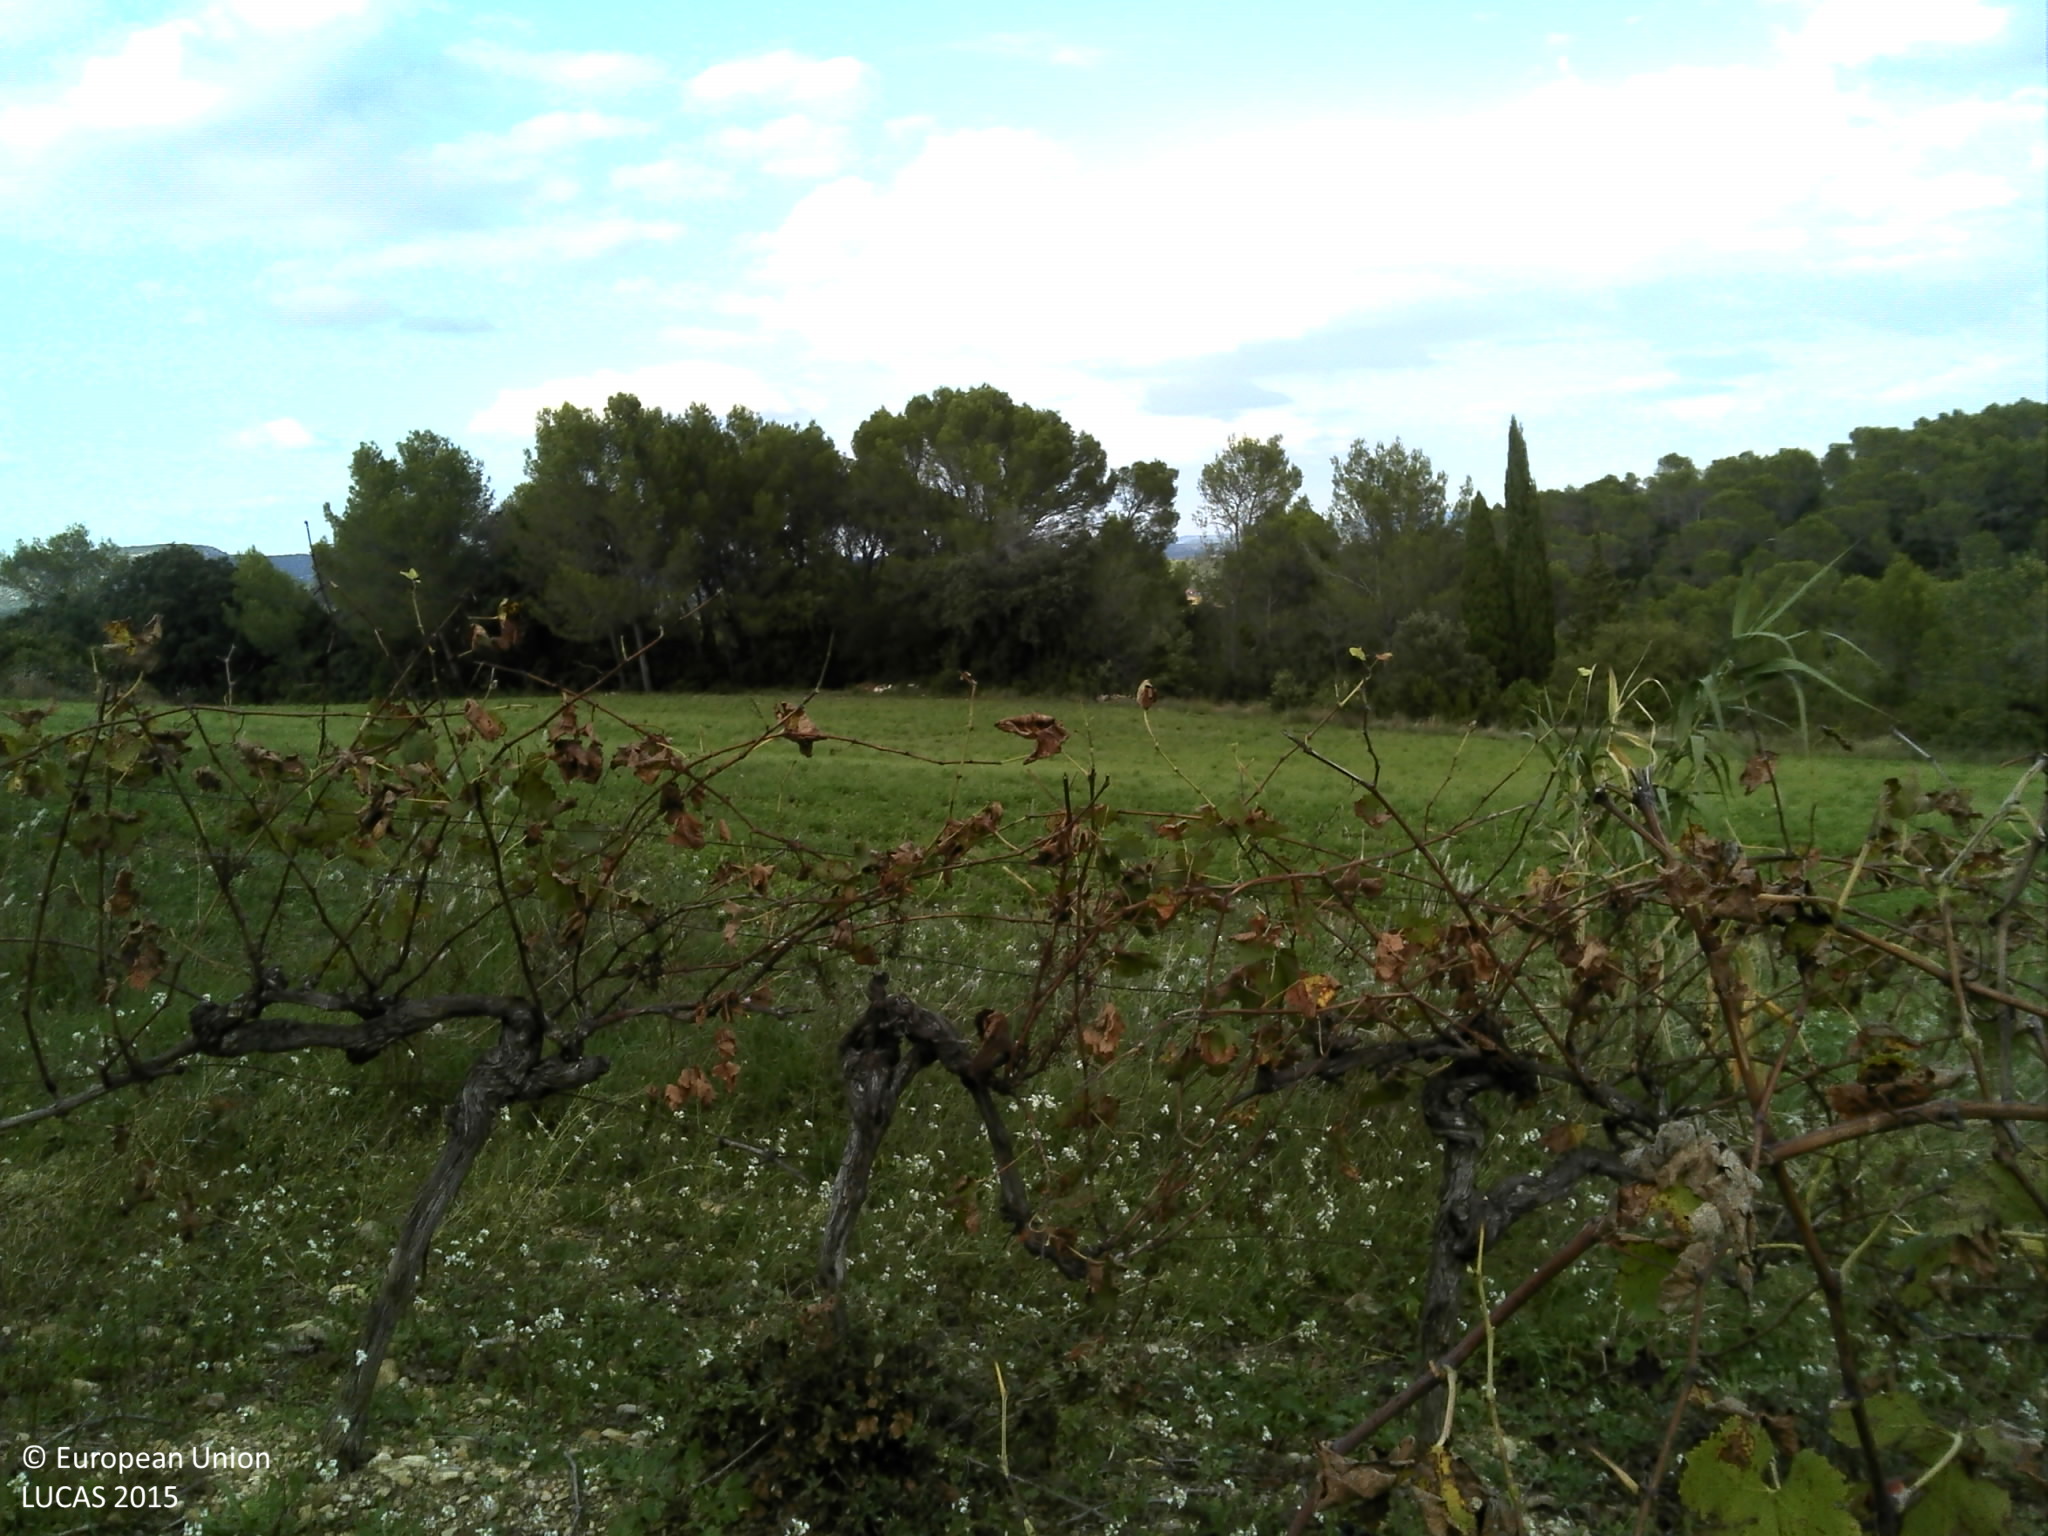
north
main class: Cropland
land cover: Vineyards
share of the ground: 10 - 25 %
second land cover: Other bare soil
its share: > 75 %
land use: Agriculture (excluding fallow land and kitchen gardens)
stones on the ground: 25 - 50 %
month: October
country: FR
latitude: 43.7421
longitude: 3.9865
